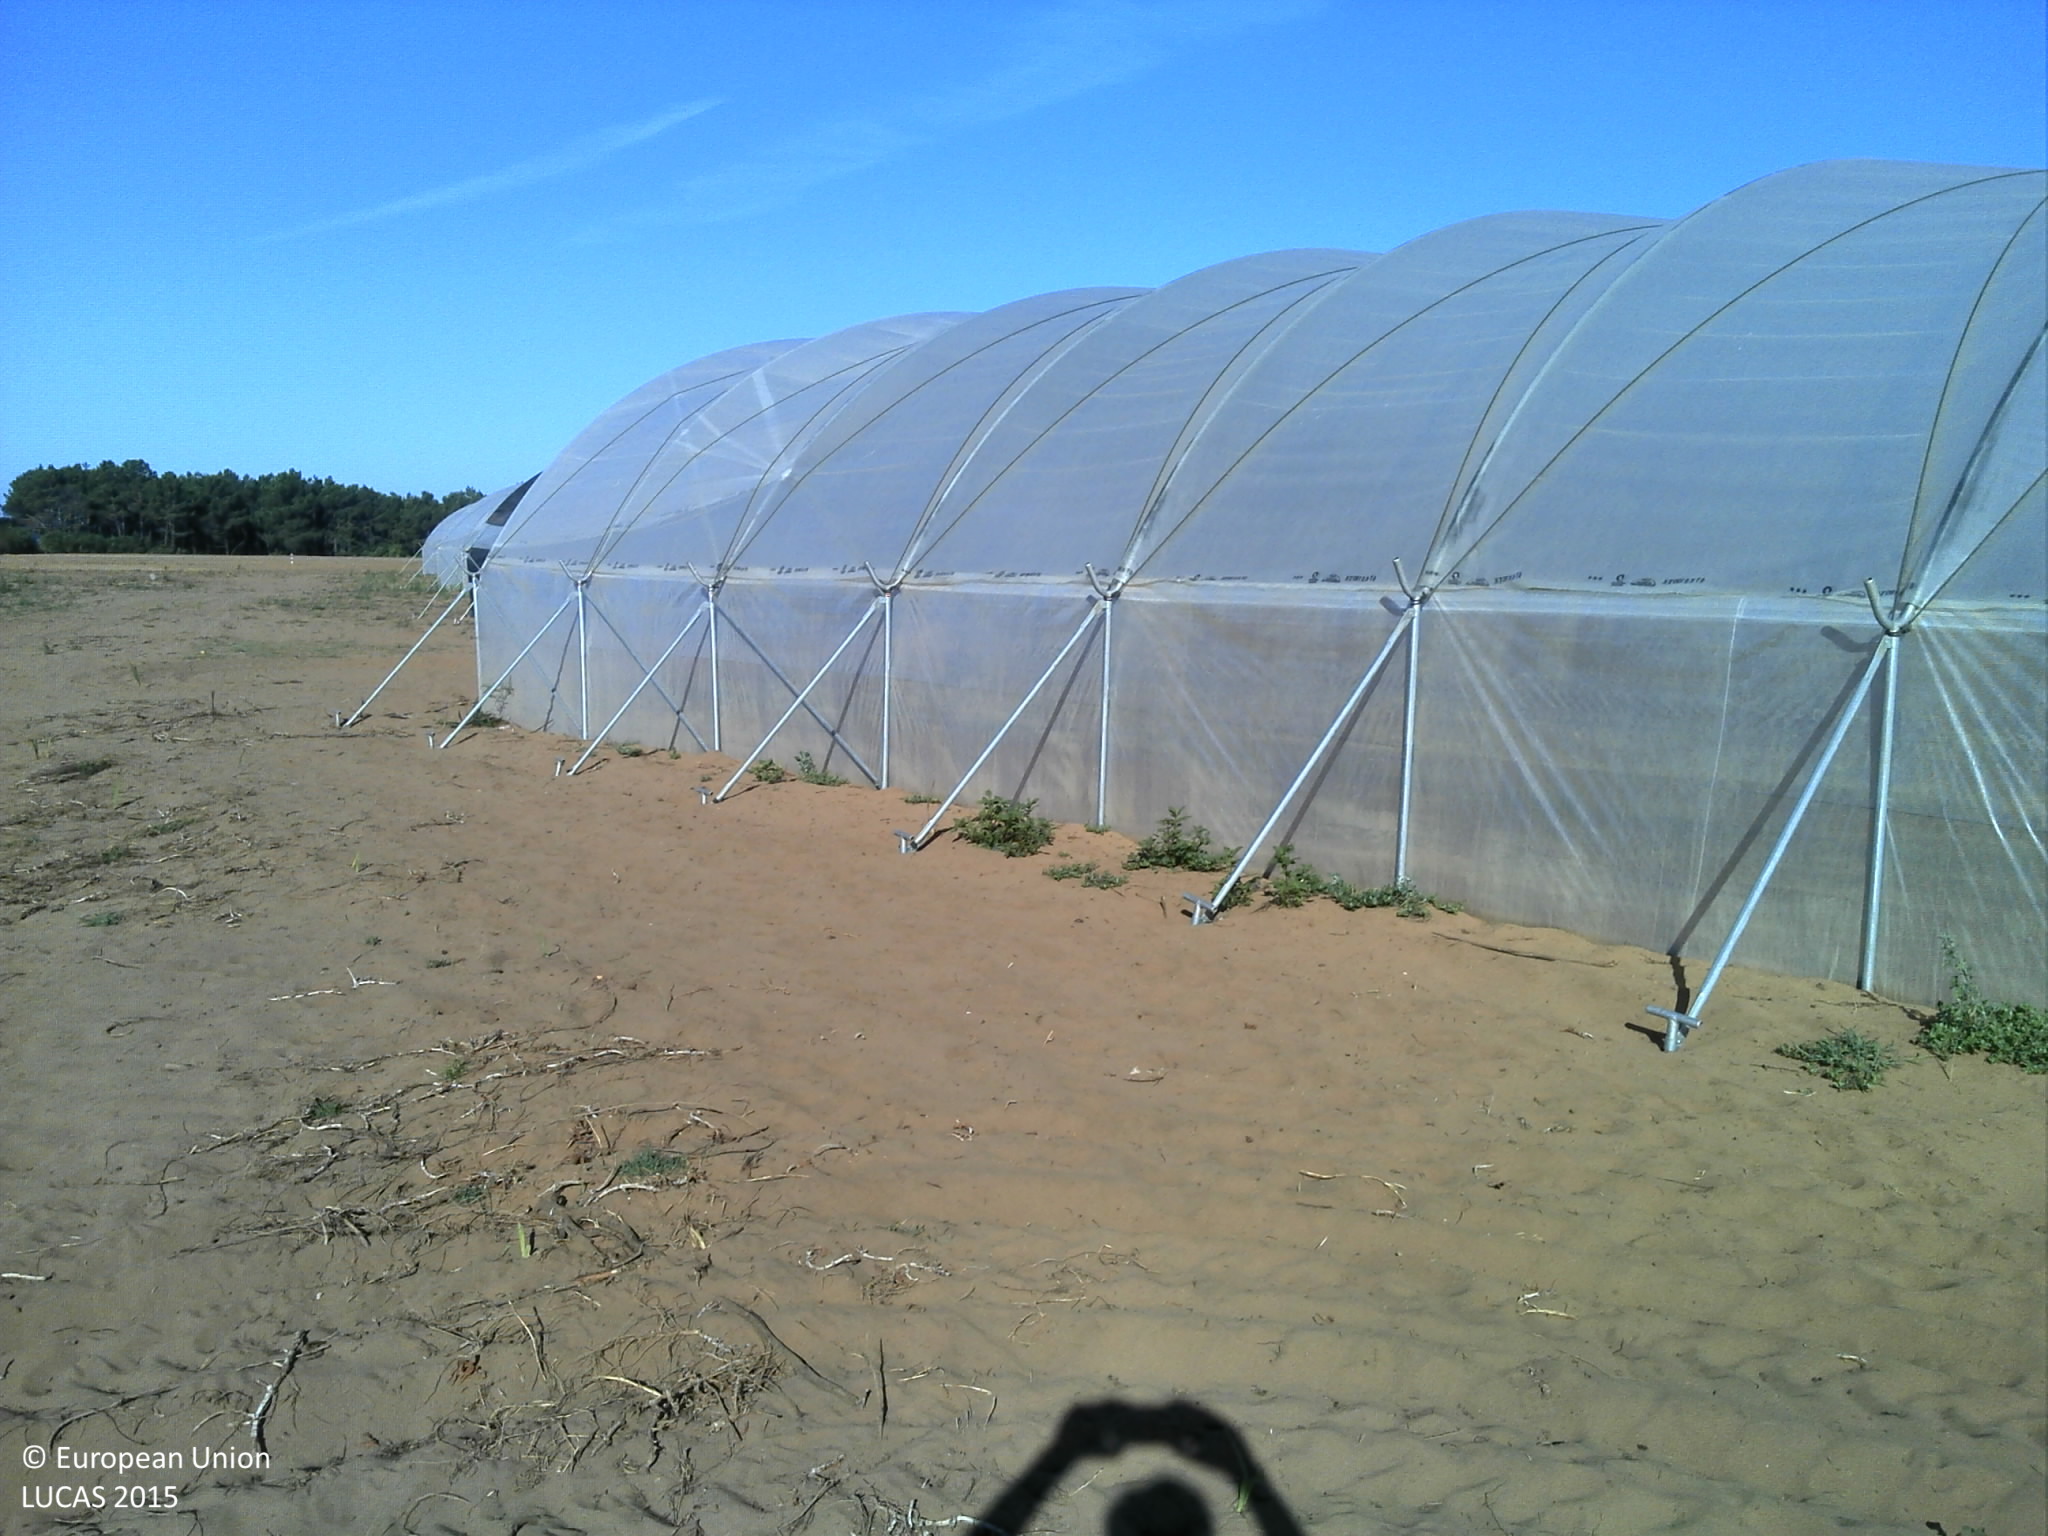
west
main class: Artificial land
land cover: Greenhouses
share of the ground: > 75 %
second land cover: Other fruit trees and berries
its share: < 10 %
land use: Agriculture (excluding fallow land and kitchen gardens)
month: June
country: PT
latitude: 37.5078
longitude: -8.7850
